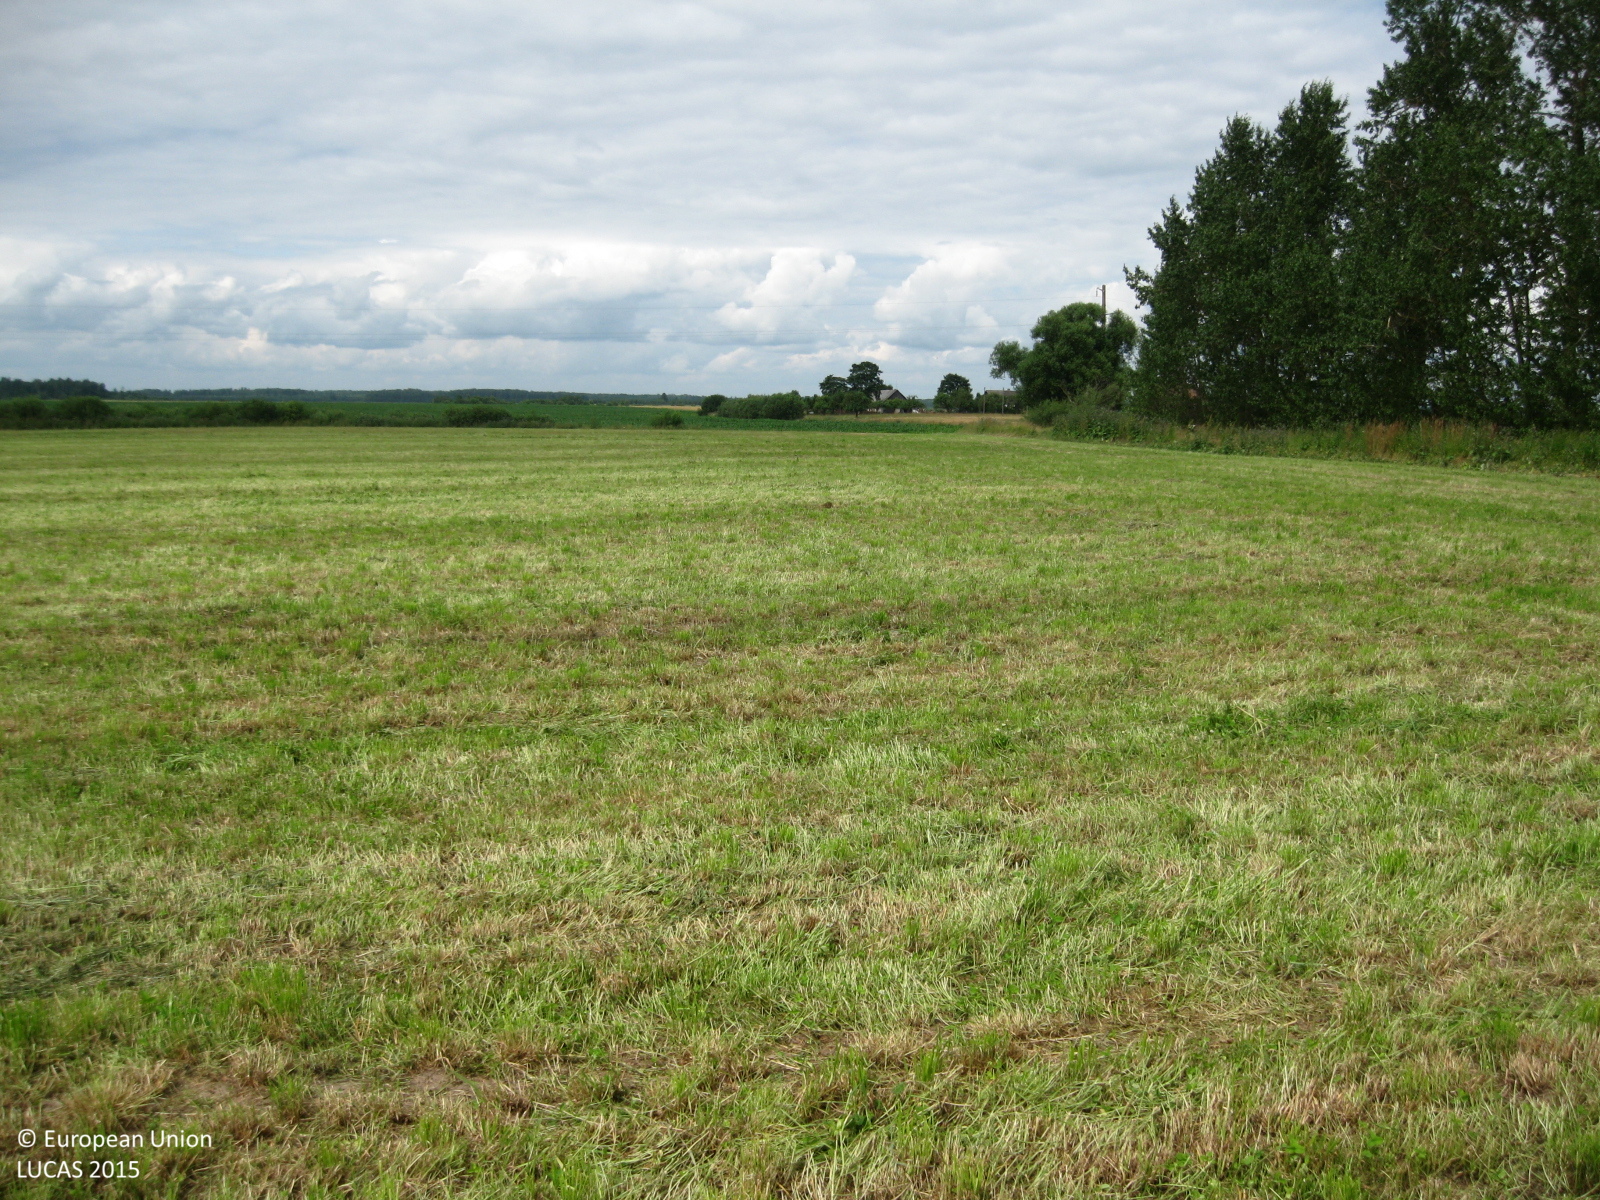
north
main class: Grassland
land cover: Grassland without tree/shrub cover
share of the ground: > 75 %
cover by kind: herbaceous plants 100 %
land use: Agriculture (excluding fallow land and kitchen gardens)
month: July
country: LT
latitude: 55.5924
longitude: 24.6867
